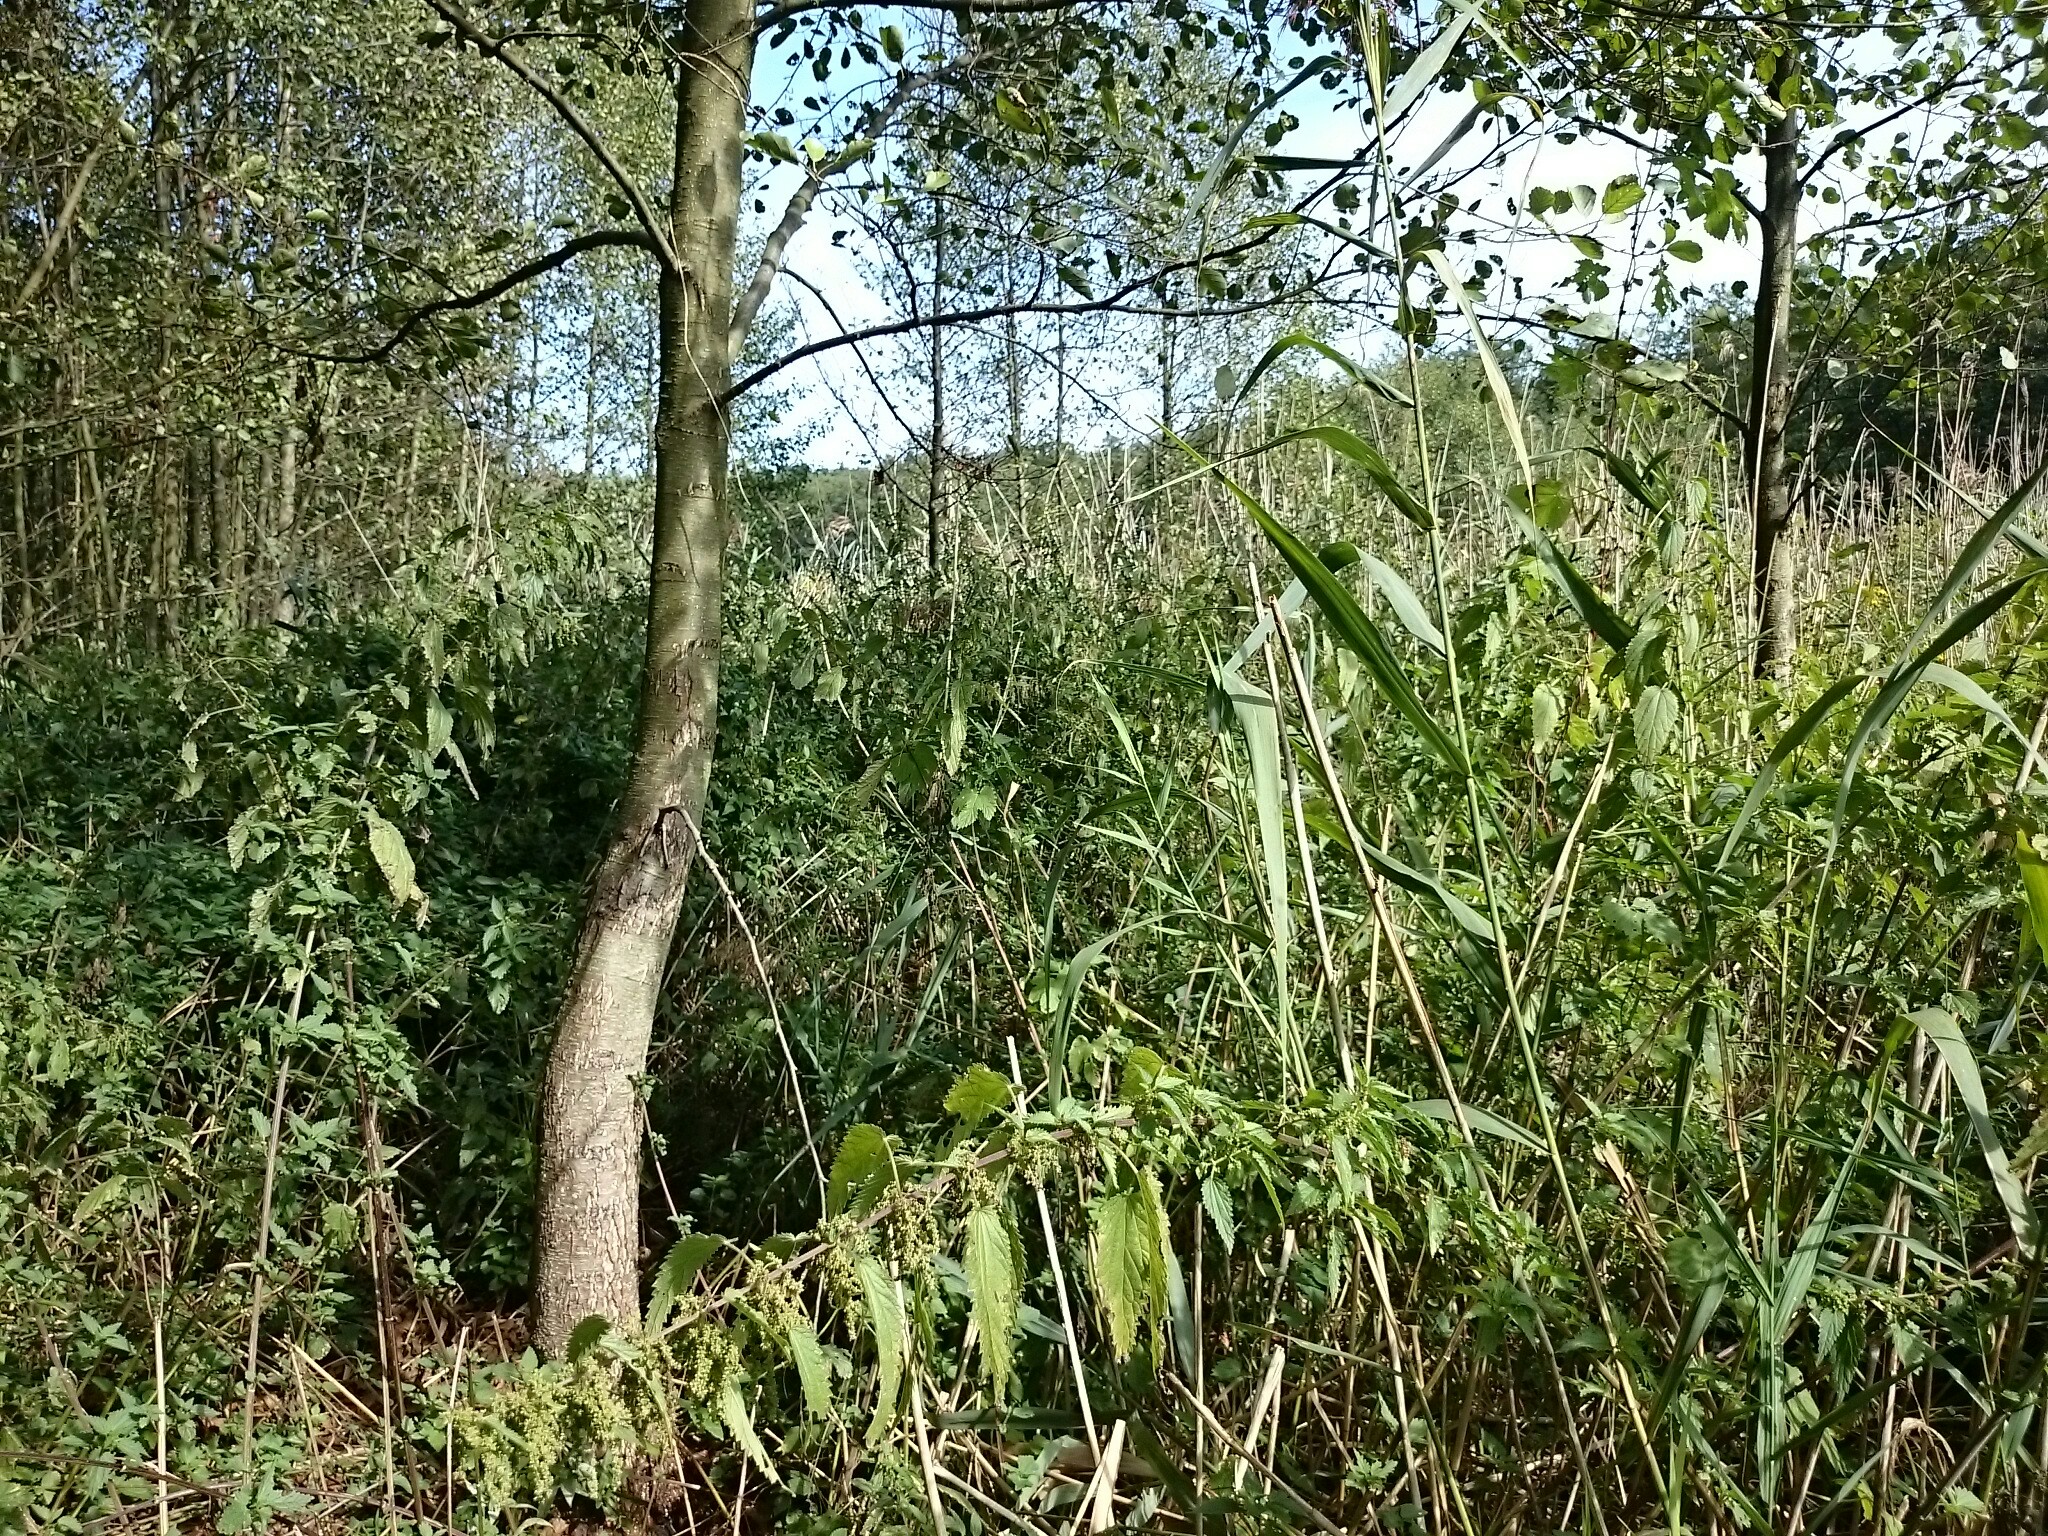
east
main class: Woodland
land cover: Broadleaved woodland
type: mesophytic deciduous forest
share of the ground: > 75 %
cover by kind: broadleaved forest trees 80 %, herbaceous plants 20 %
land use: Forestry
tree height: > 5 m
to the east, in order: Broadleaved woodland; Rivers and streams; Broadleaved woodland; Spontaneously vegetated surfaces; Broadleaved woodland; Ditches and canals; Grassland without tree/shrub cover
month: September
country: PL
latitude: 51.1783
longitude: 17.2928
